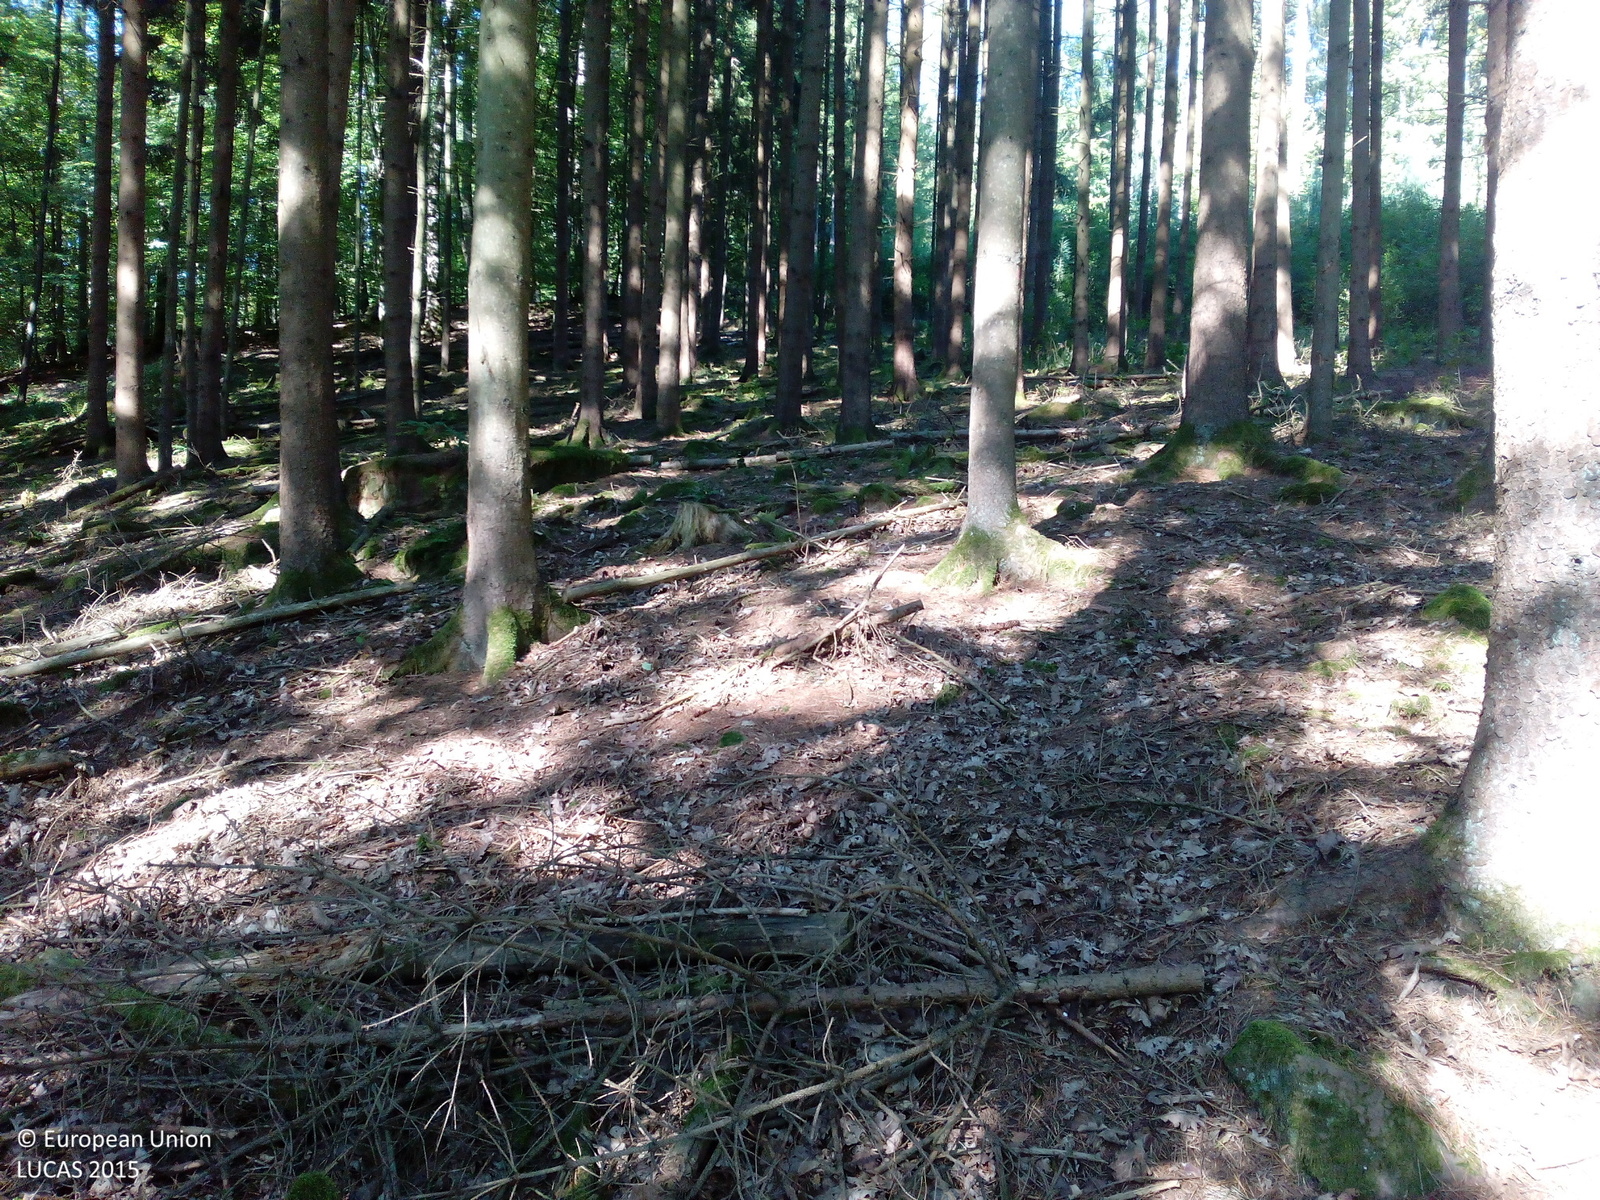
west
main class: Woodland
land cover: Spruce dominated coniferous woodland
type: hemiboreal forest and nemoral coniferous forest and mixed broadleaved-coniferous forest
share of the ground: > 75 %
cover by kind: coniferous forest trees 90 %, unconsolidated bare surface 10 %
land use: Forestry
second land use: Amenities, museums, leisure
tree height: > 5 m
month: September
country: DE
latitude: 49.9137
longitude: 9.5684
